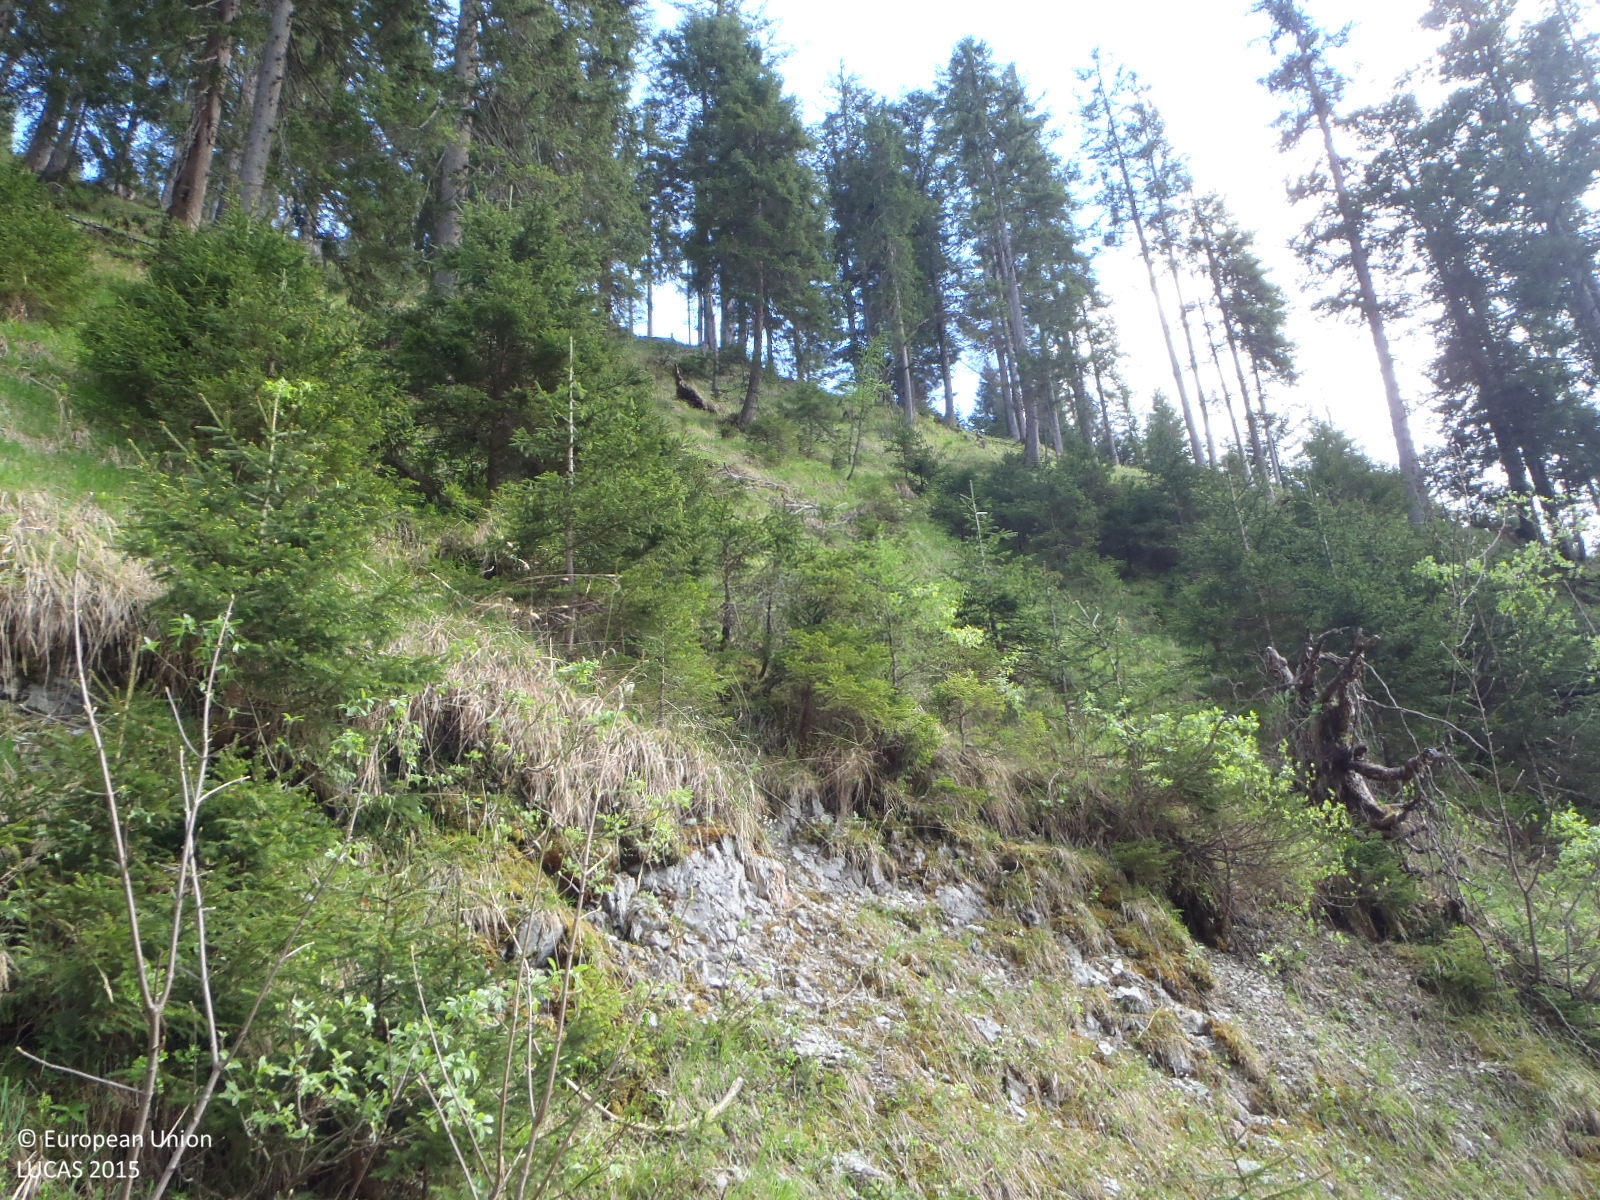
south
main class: Woodland
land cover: Spruce dominated coniferous woodland
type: alpine coniferous forest
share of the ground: 25 - 50 %
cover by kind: herbaceous plants 50 %, coniferous forest trees 40 %, shrubs 5 %, lichens and mosses 5 %
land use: Forestry
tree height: > 5 m
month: May
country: AT
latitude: 47.3229
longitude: 13.4514
